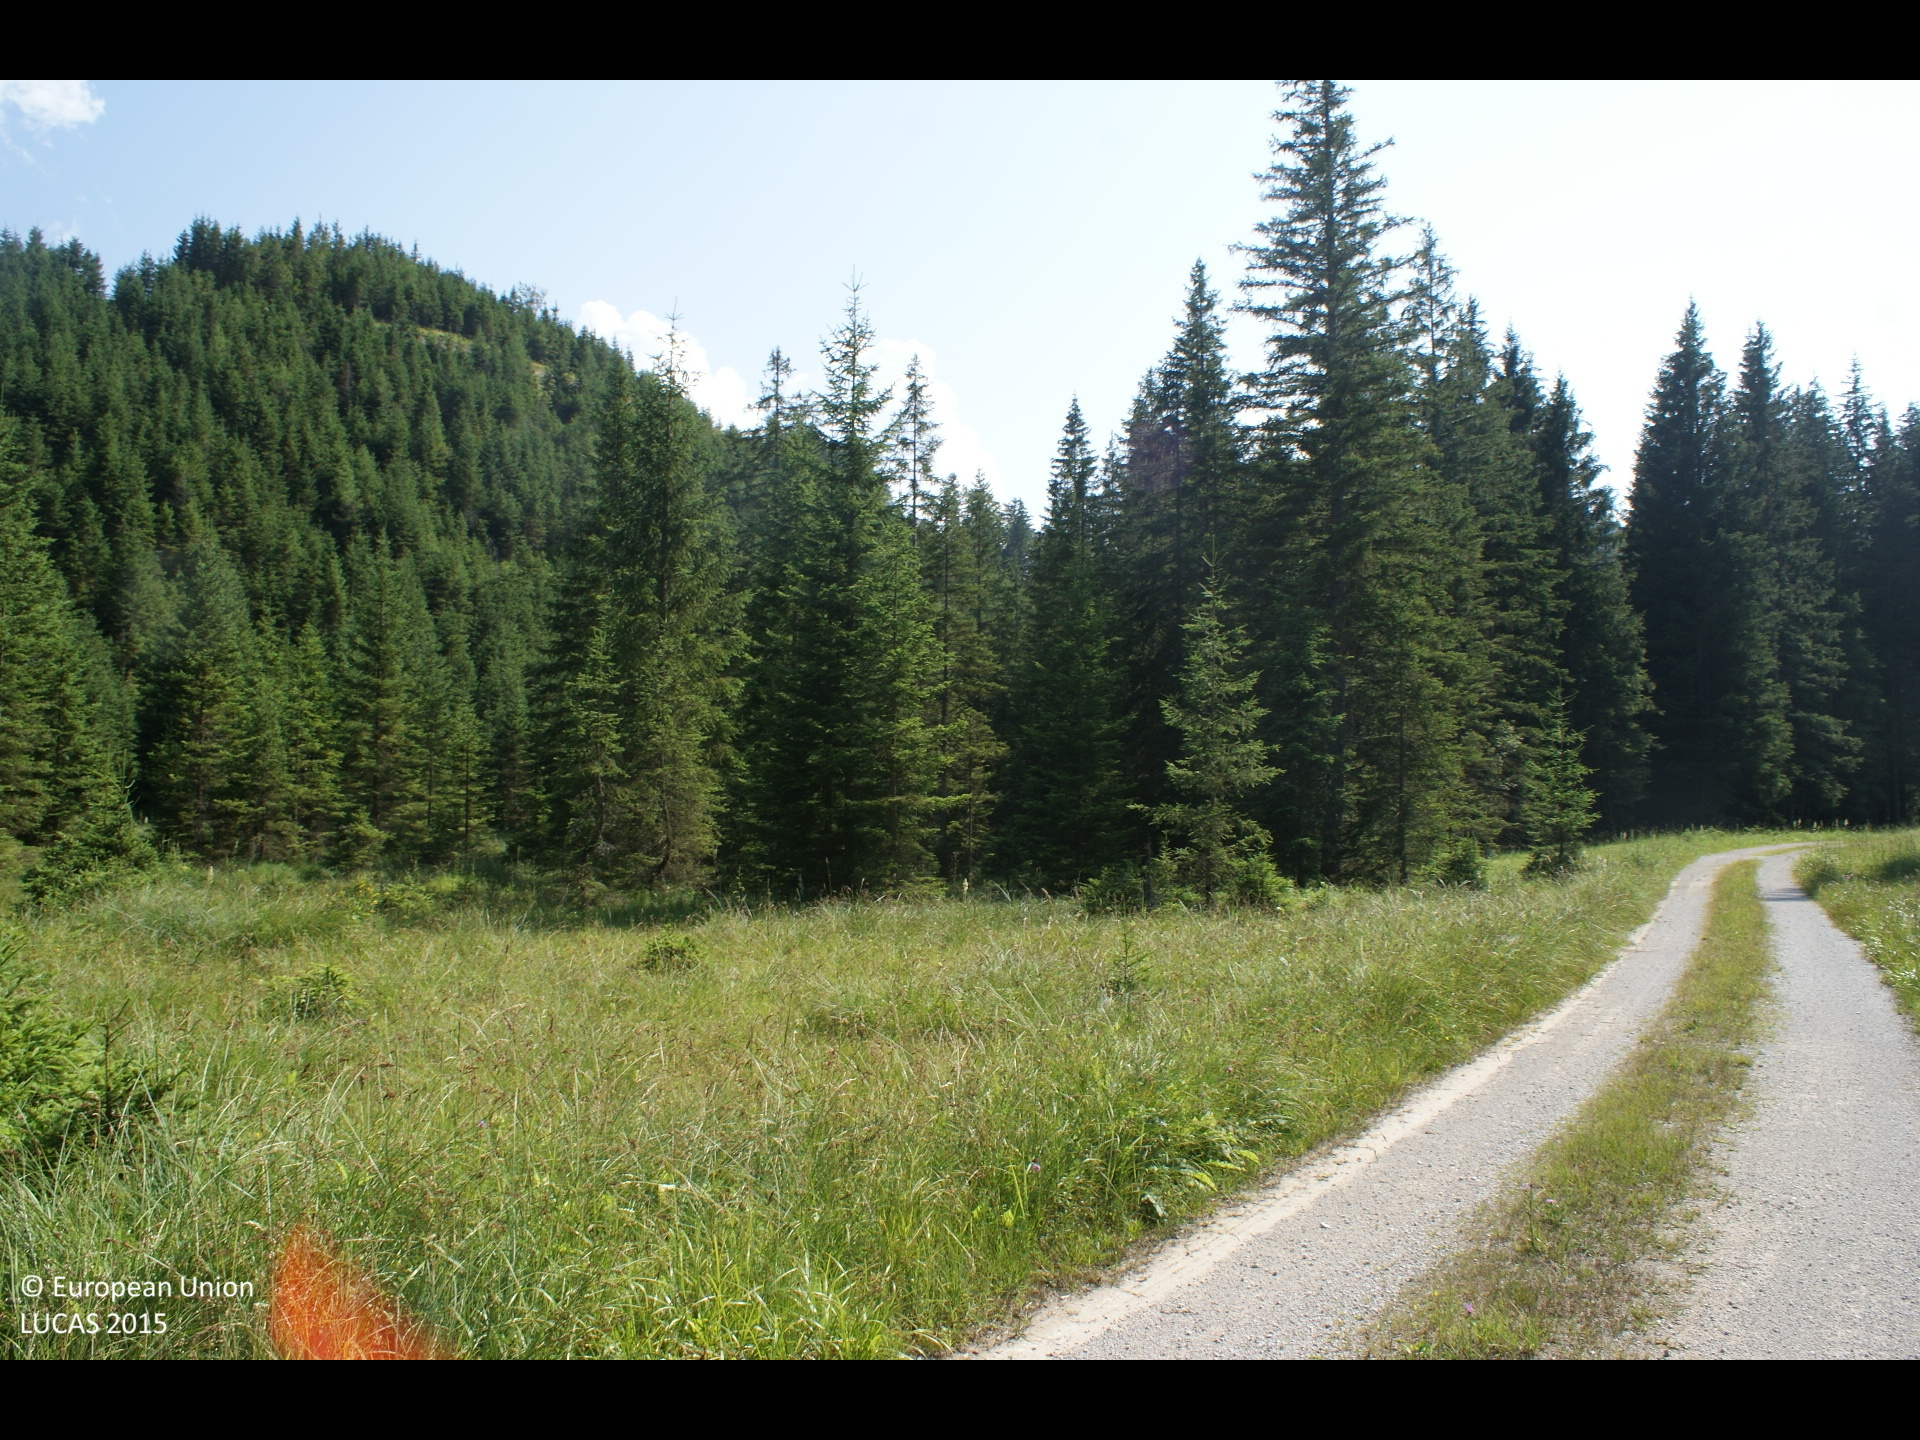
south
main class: Grassland
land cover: Spontaneously vegetated surfaces
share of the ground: > 75 %
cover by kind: herbaceous plants 100 %
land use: Semi-natural and natural areas not in use
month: July
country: AT
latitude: 47.8561
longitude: 15.4145
